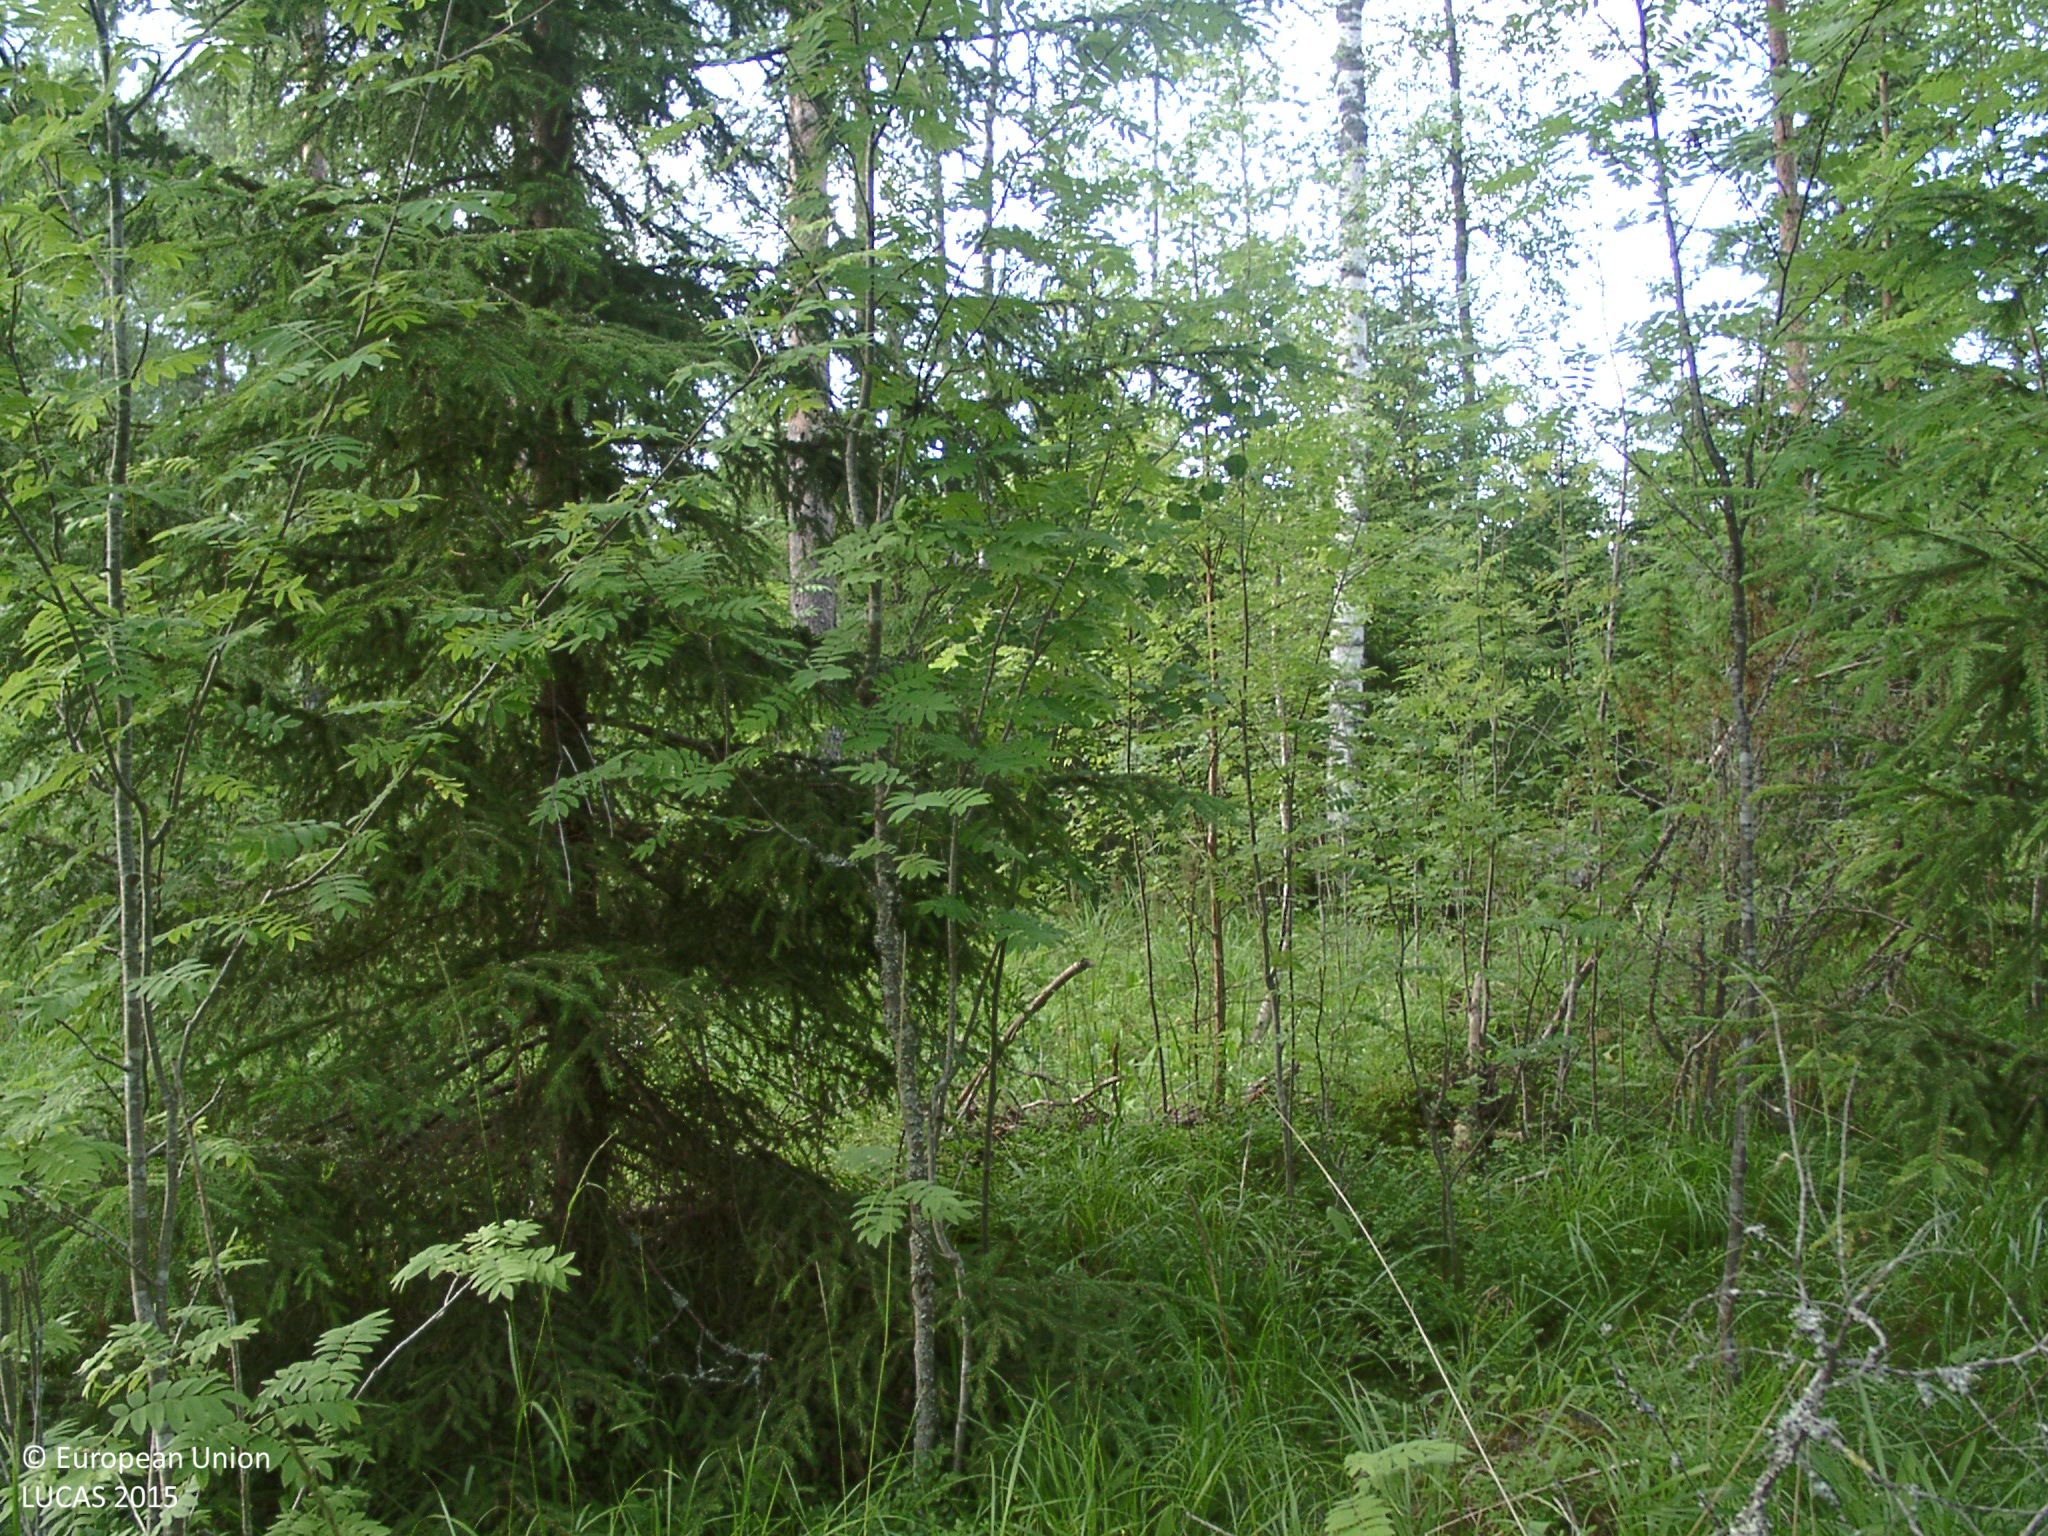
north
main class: Woodland
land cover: Other mixed woodland
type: boreal forest
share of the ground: 50 - 75 %
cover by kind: coniferous forest trees 50 %, broadleaved forest trees 20 %, shrubs 15 %, herbaceous plants 10 %, lichens and mosses 5 %
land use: Semi-natural and natural areas not in use
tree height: > 5 m
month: July
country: FI
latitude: 61.5800
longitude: 25.1617
